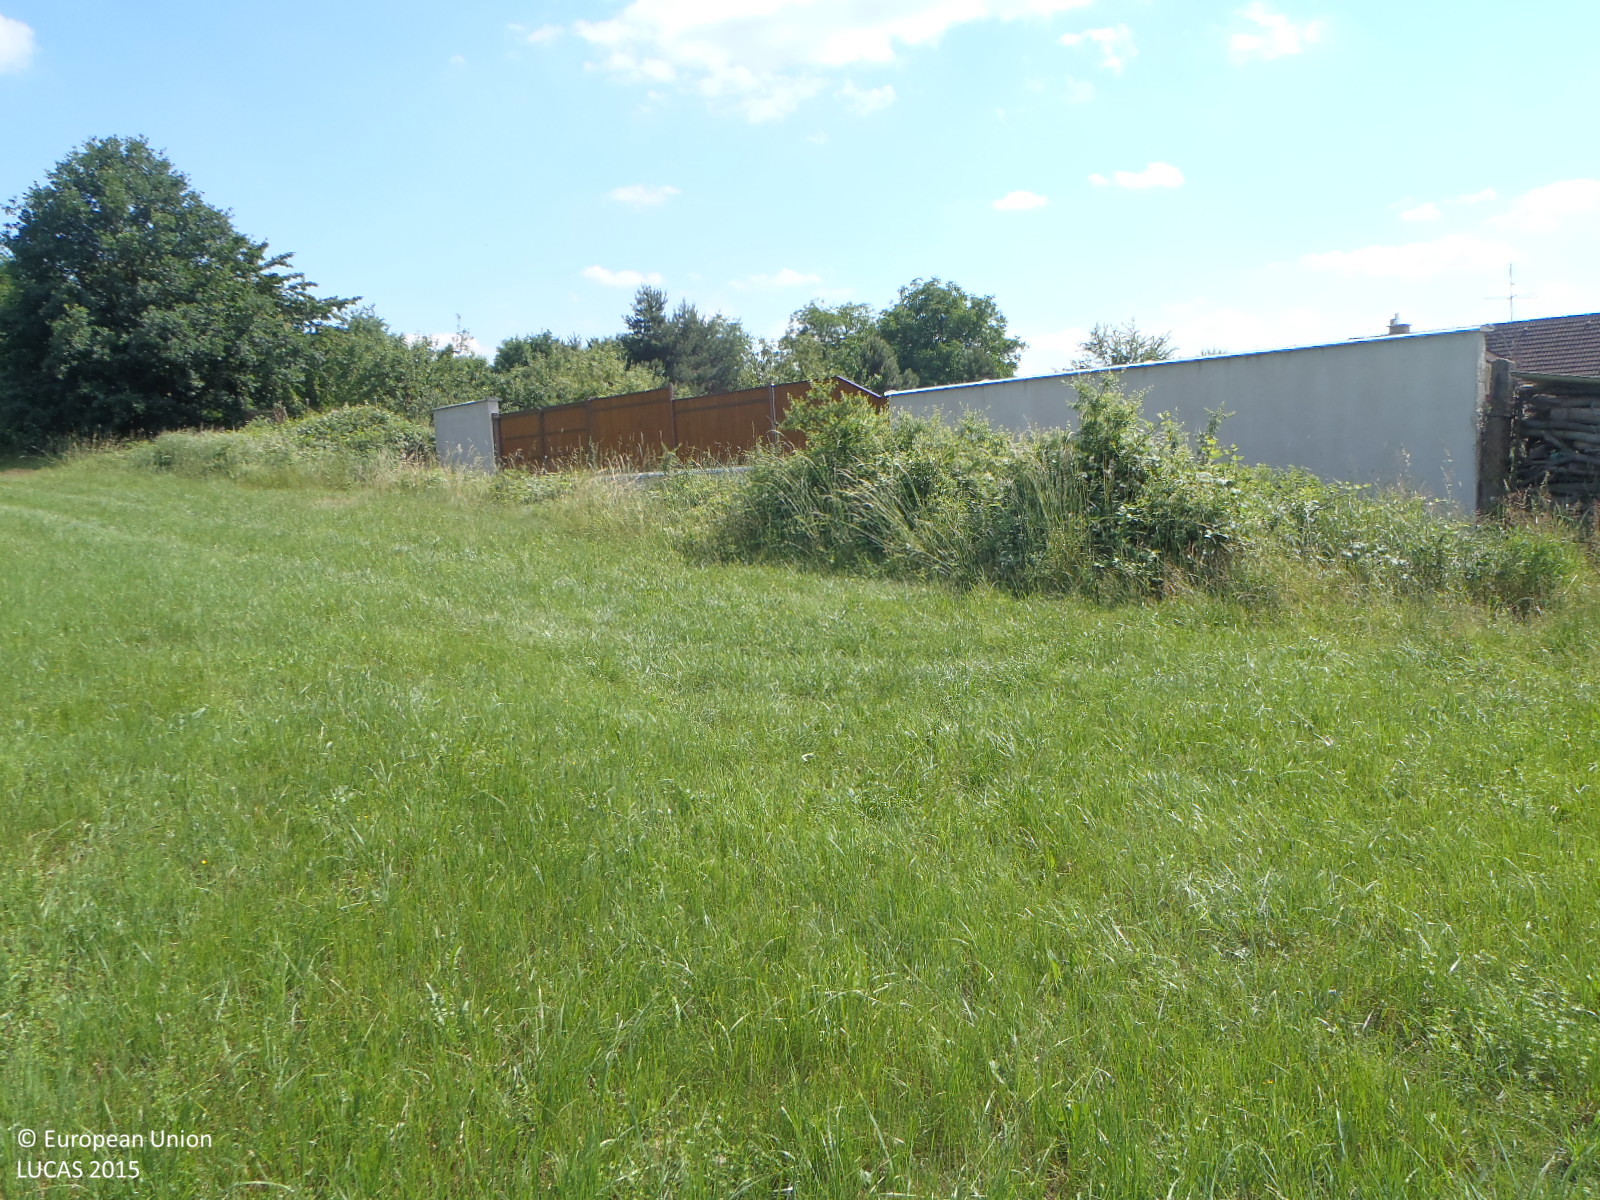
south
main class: Grassland
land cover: Grassland without tree/shrub cover
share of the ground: > 75 %
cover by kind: herbaceous plants 100 %
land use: Agriculture (excluding fallow land and kitchen gardens)
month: June
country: CZ
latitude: 49.0528
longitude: 14.4482
